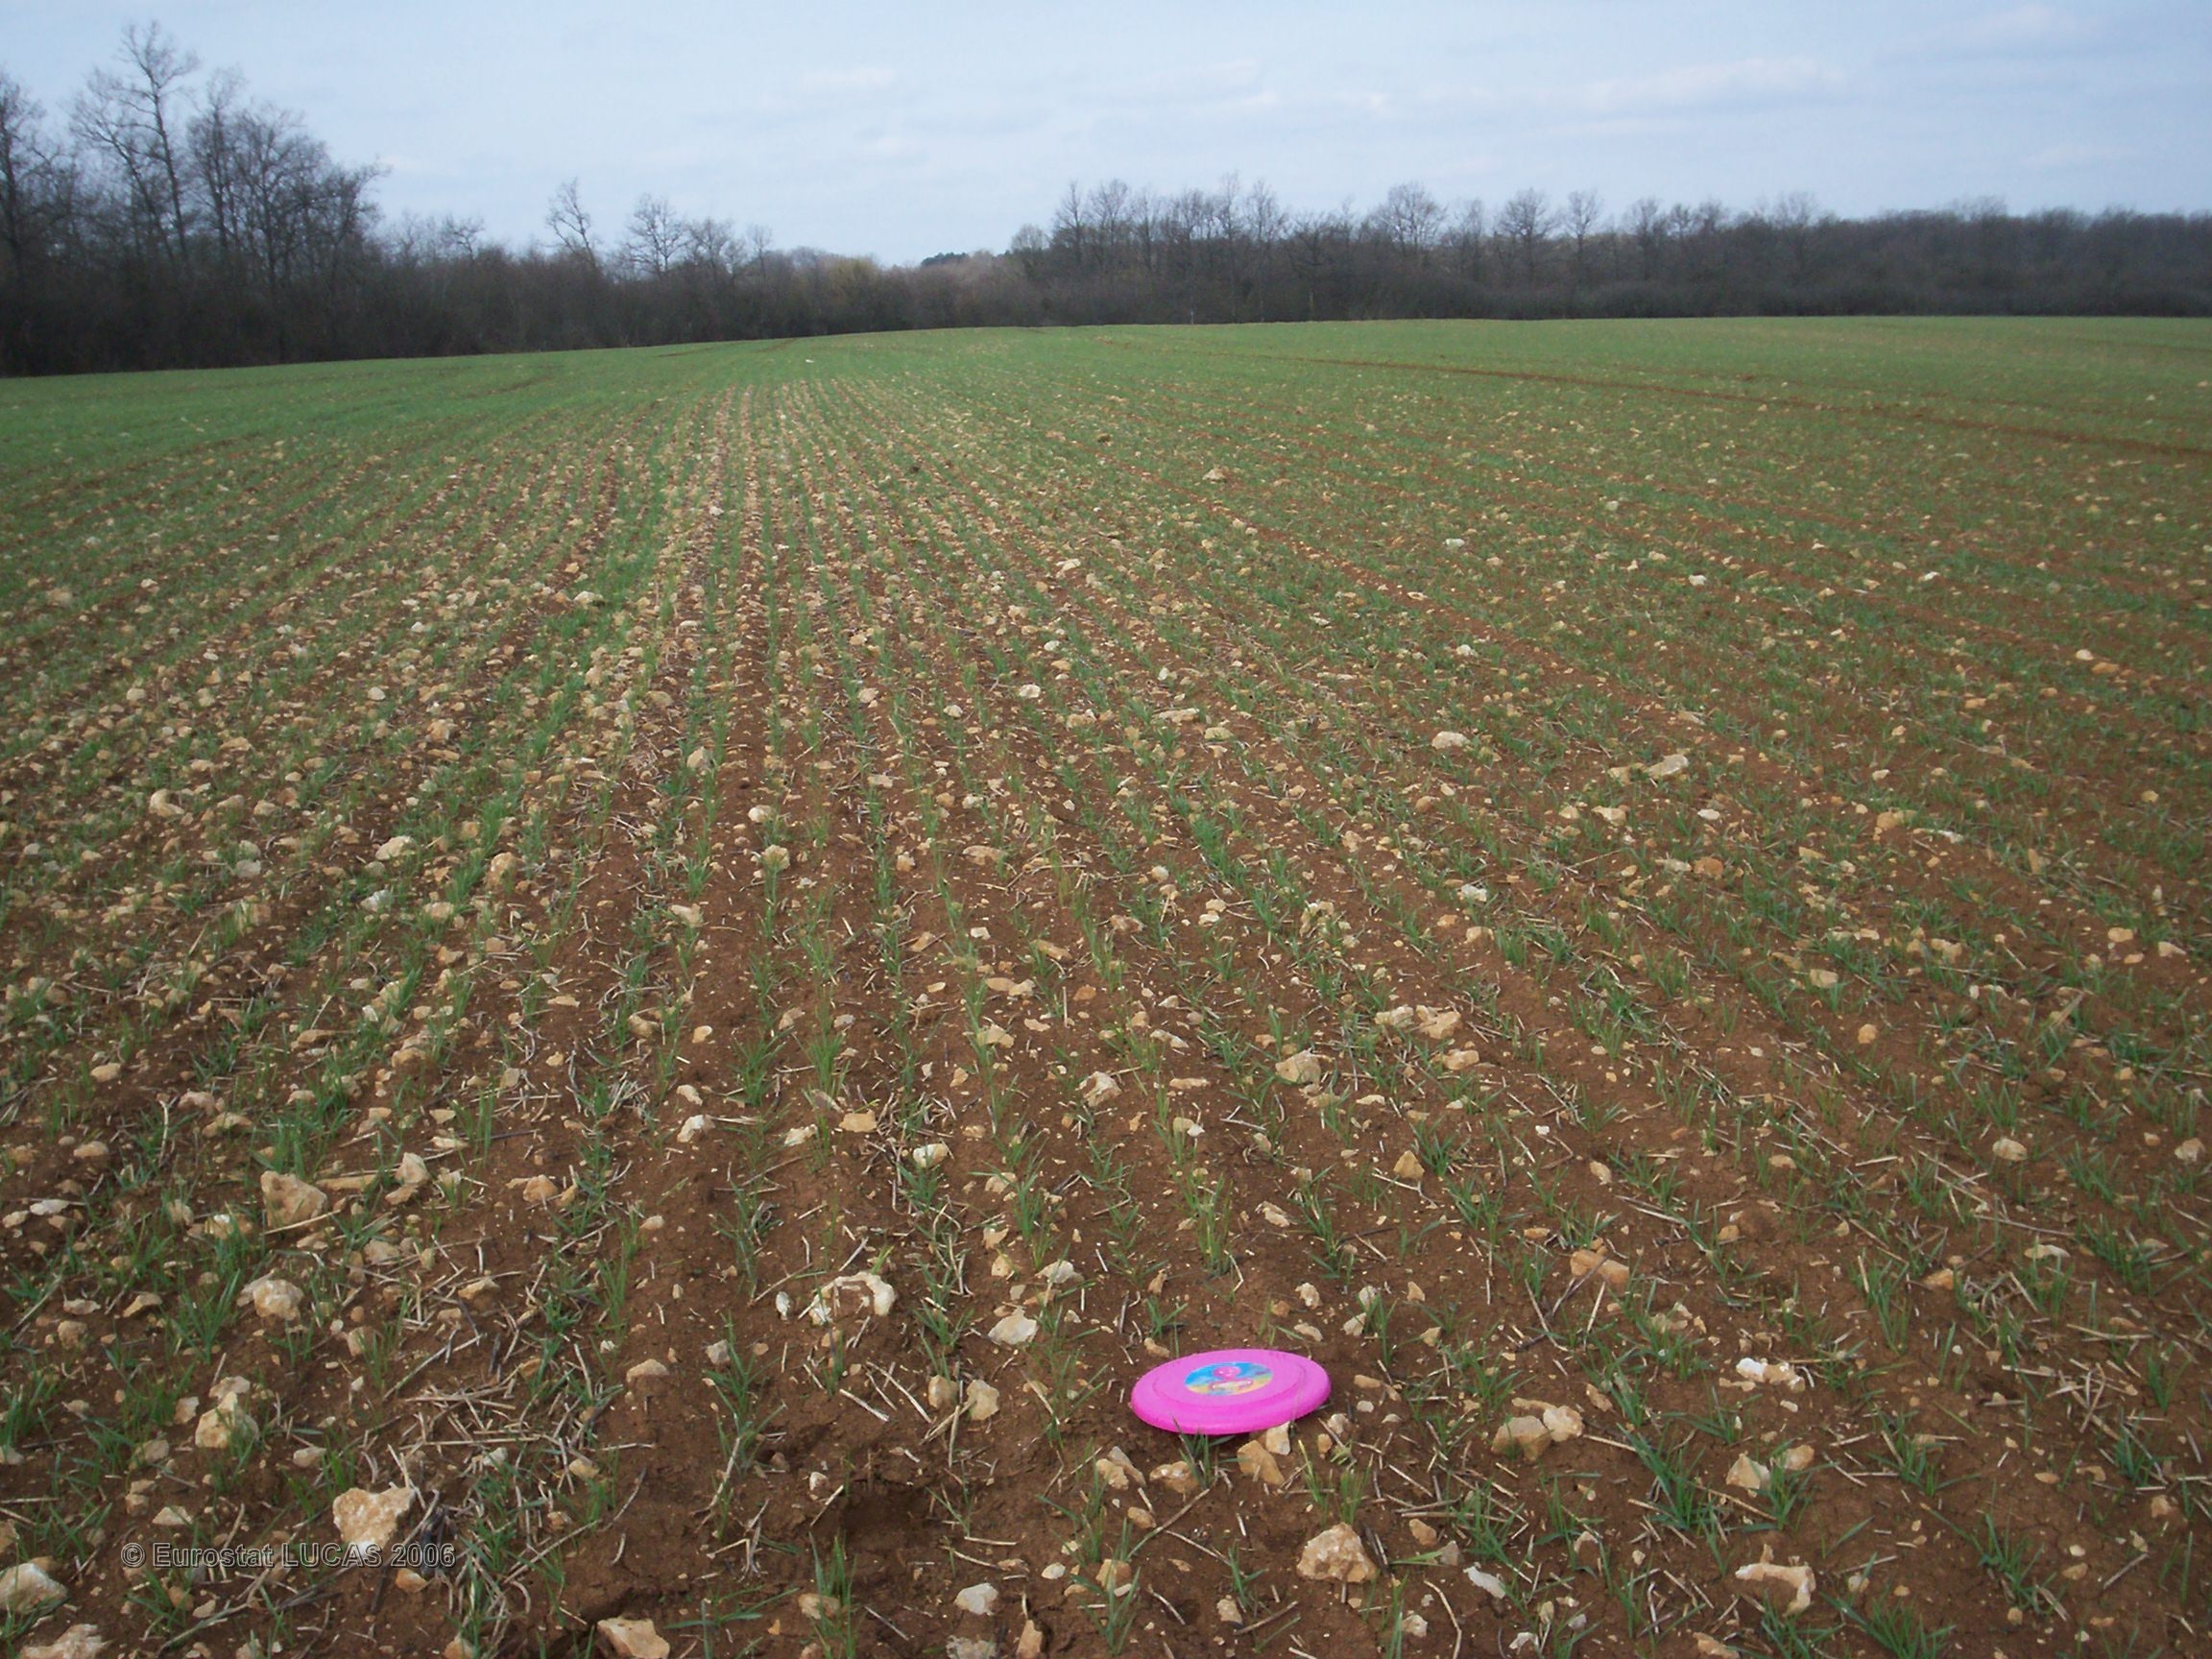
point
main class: Cropland
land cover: Common wheat
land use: Agriculture (excluding fallow land and kitchen gardens)
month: April
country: FR
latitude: 47.8342
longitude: 5.2839
